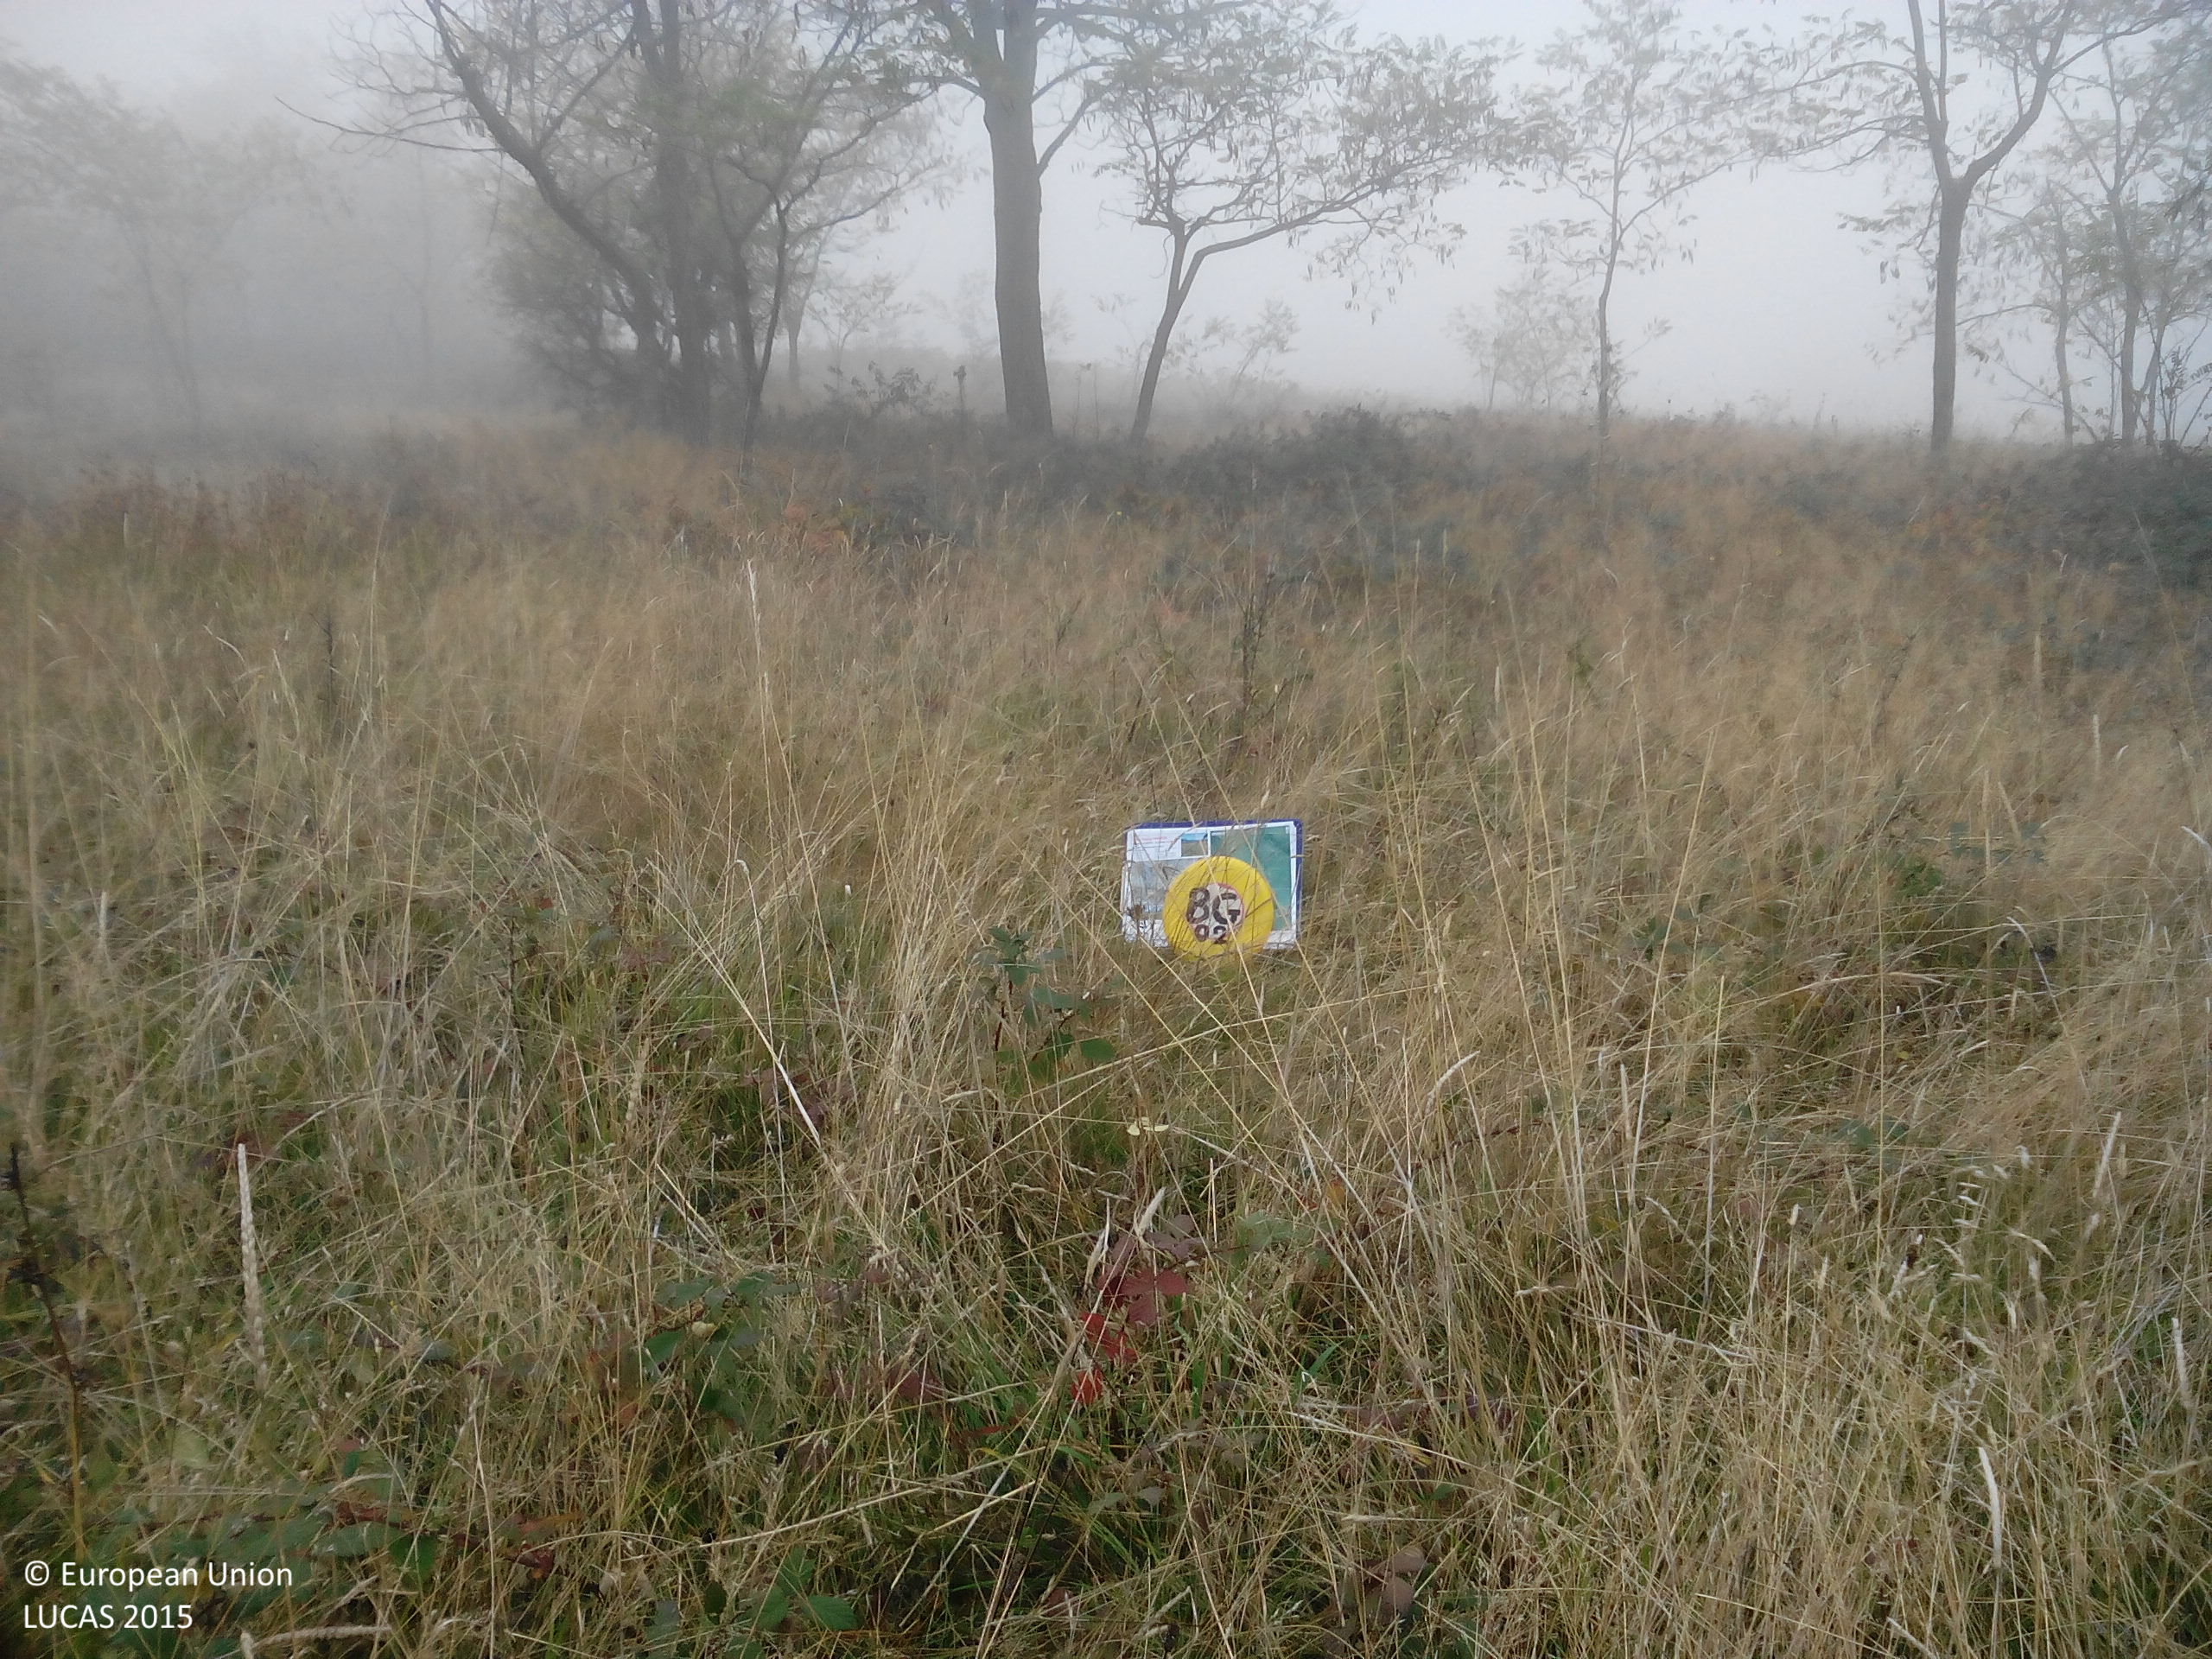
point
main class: Grassland
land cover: Grassland without tree/shrub cover
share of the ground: > 75 %
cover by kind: herbaceous plants 100 %
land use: Agriculture (excluding fallow land and kitchen gardens)
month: October
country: BG
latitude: 43.0266
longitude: 24.0264
